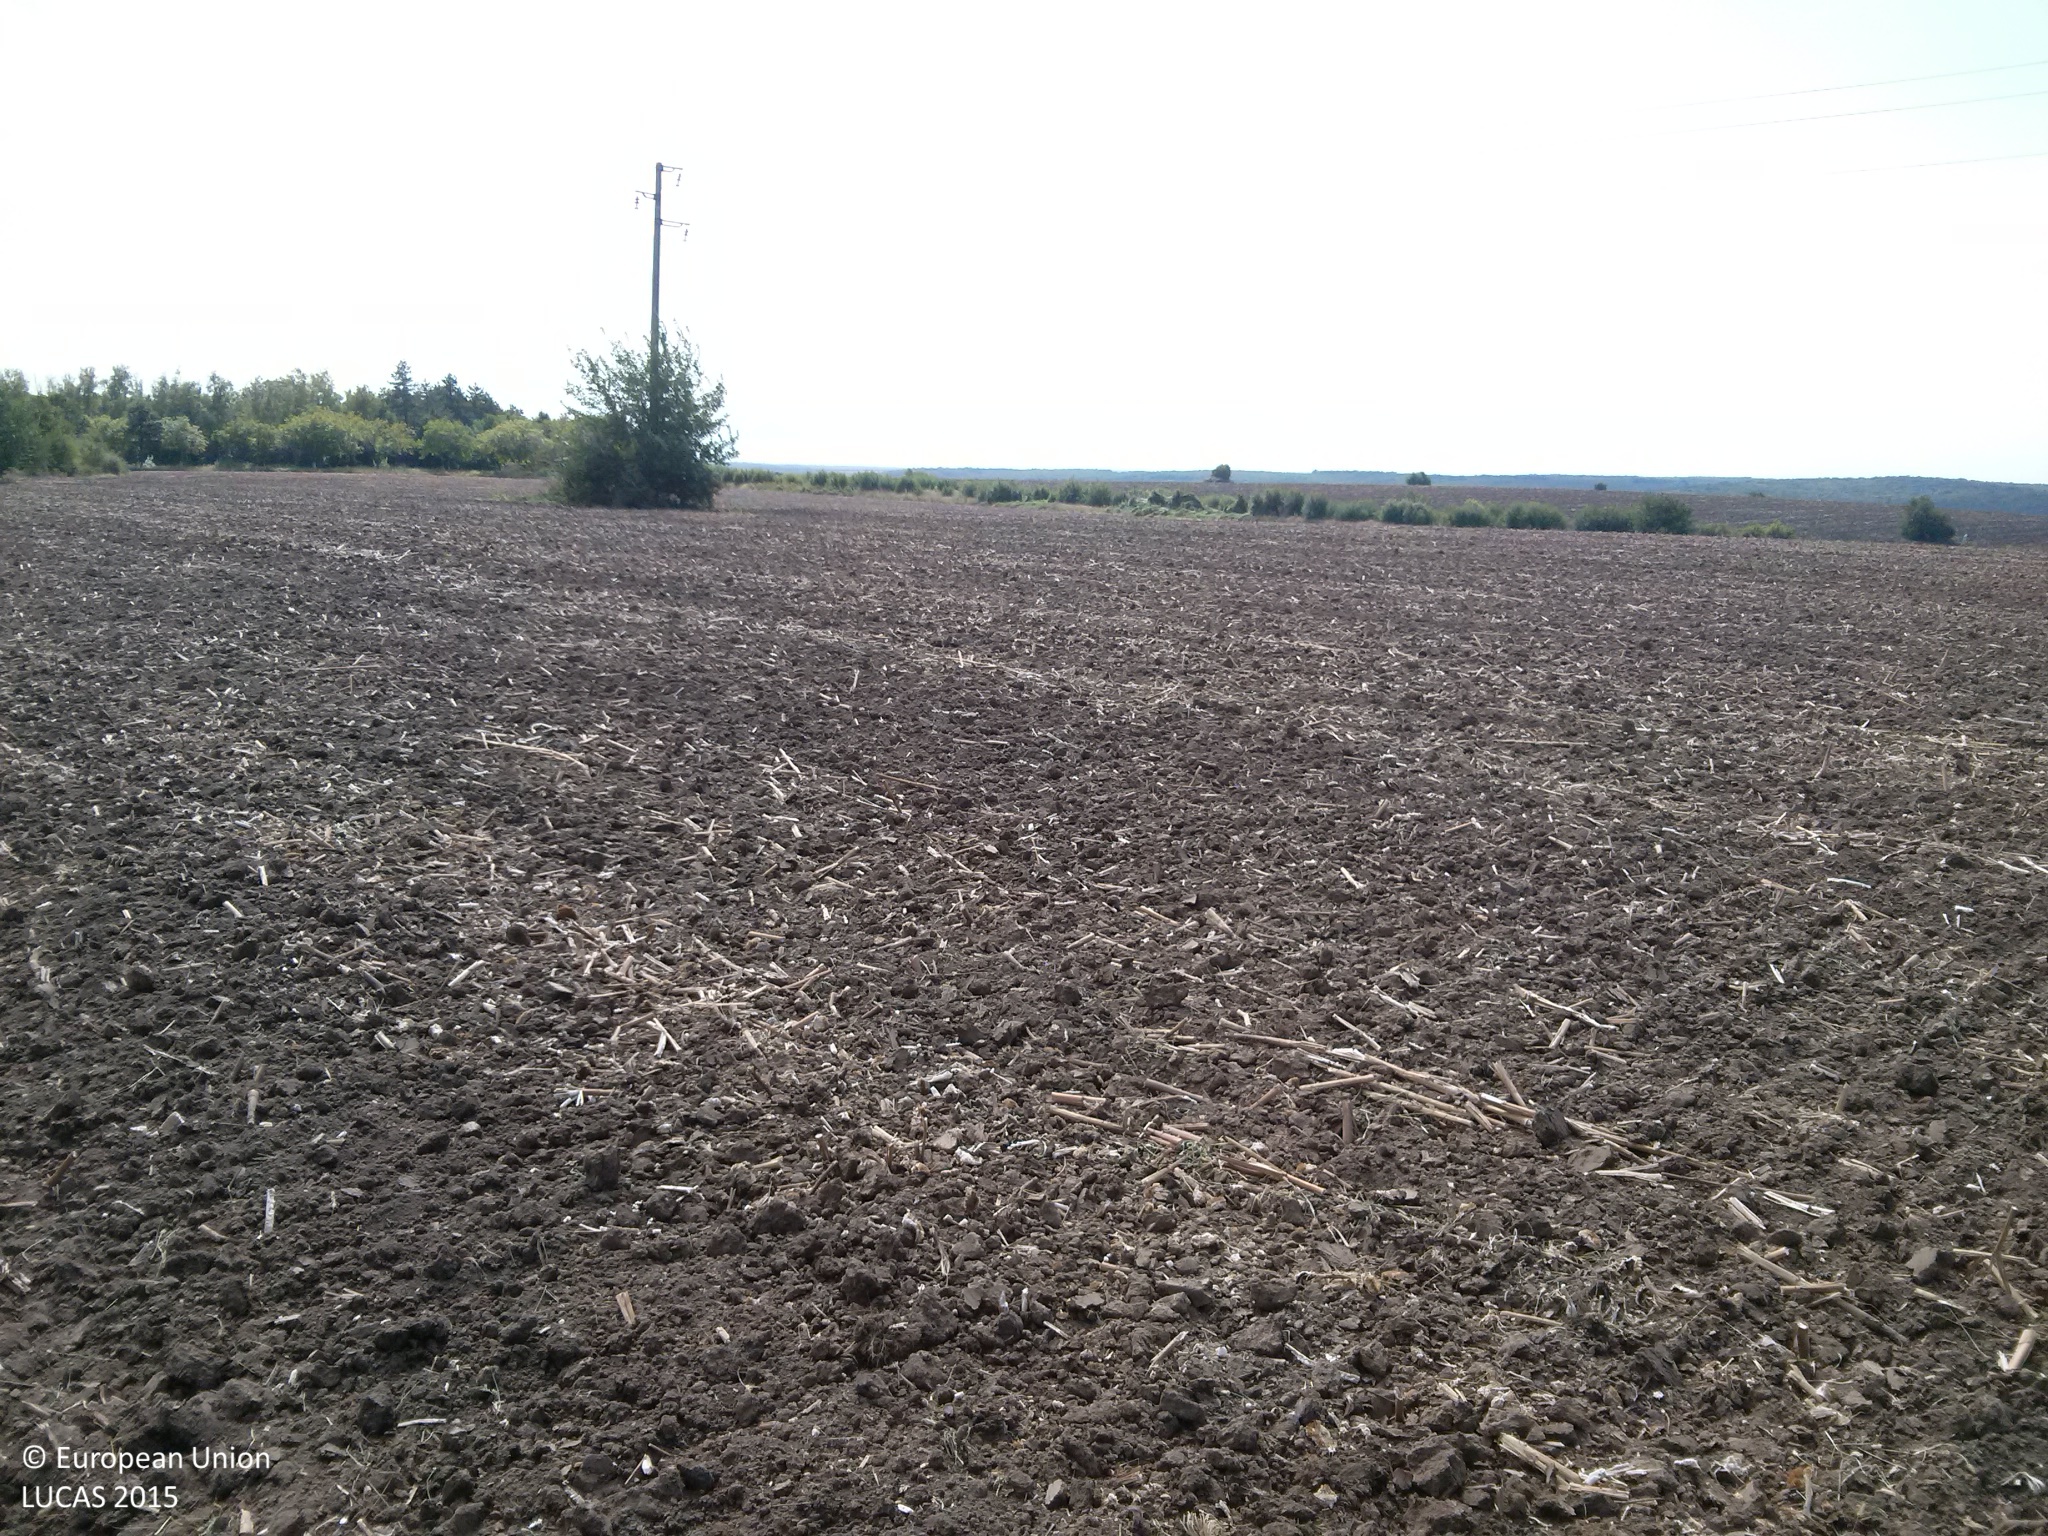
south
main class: Cropland
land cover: Sunflower
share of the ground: < 10 %
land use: Agriculture (excluding fallow land and kitchen gardens)
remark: Harvested field
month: September
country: BG
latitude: 43.8845
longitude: 26.3738
